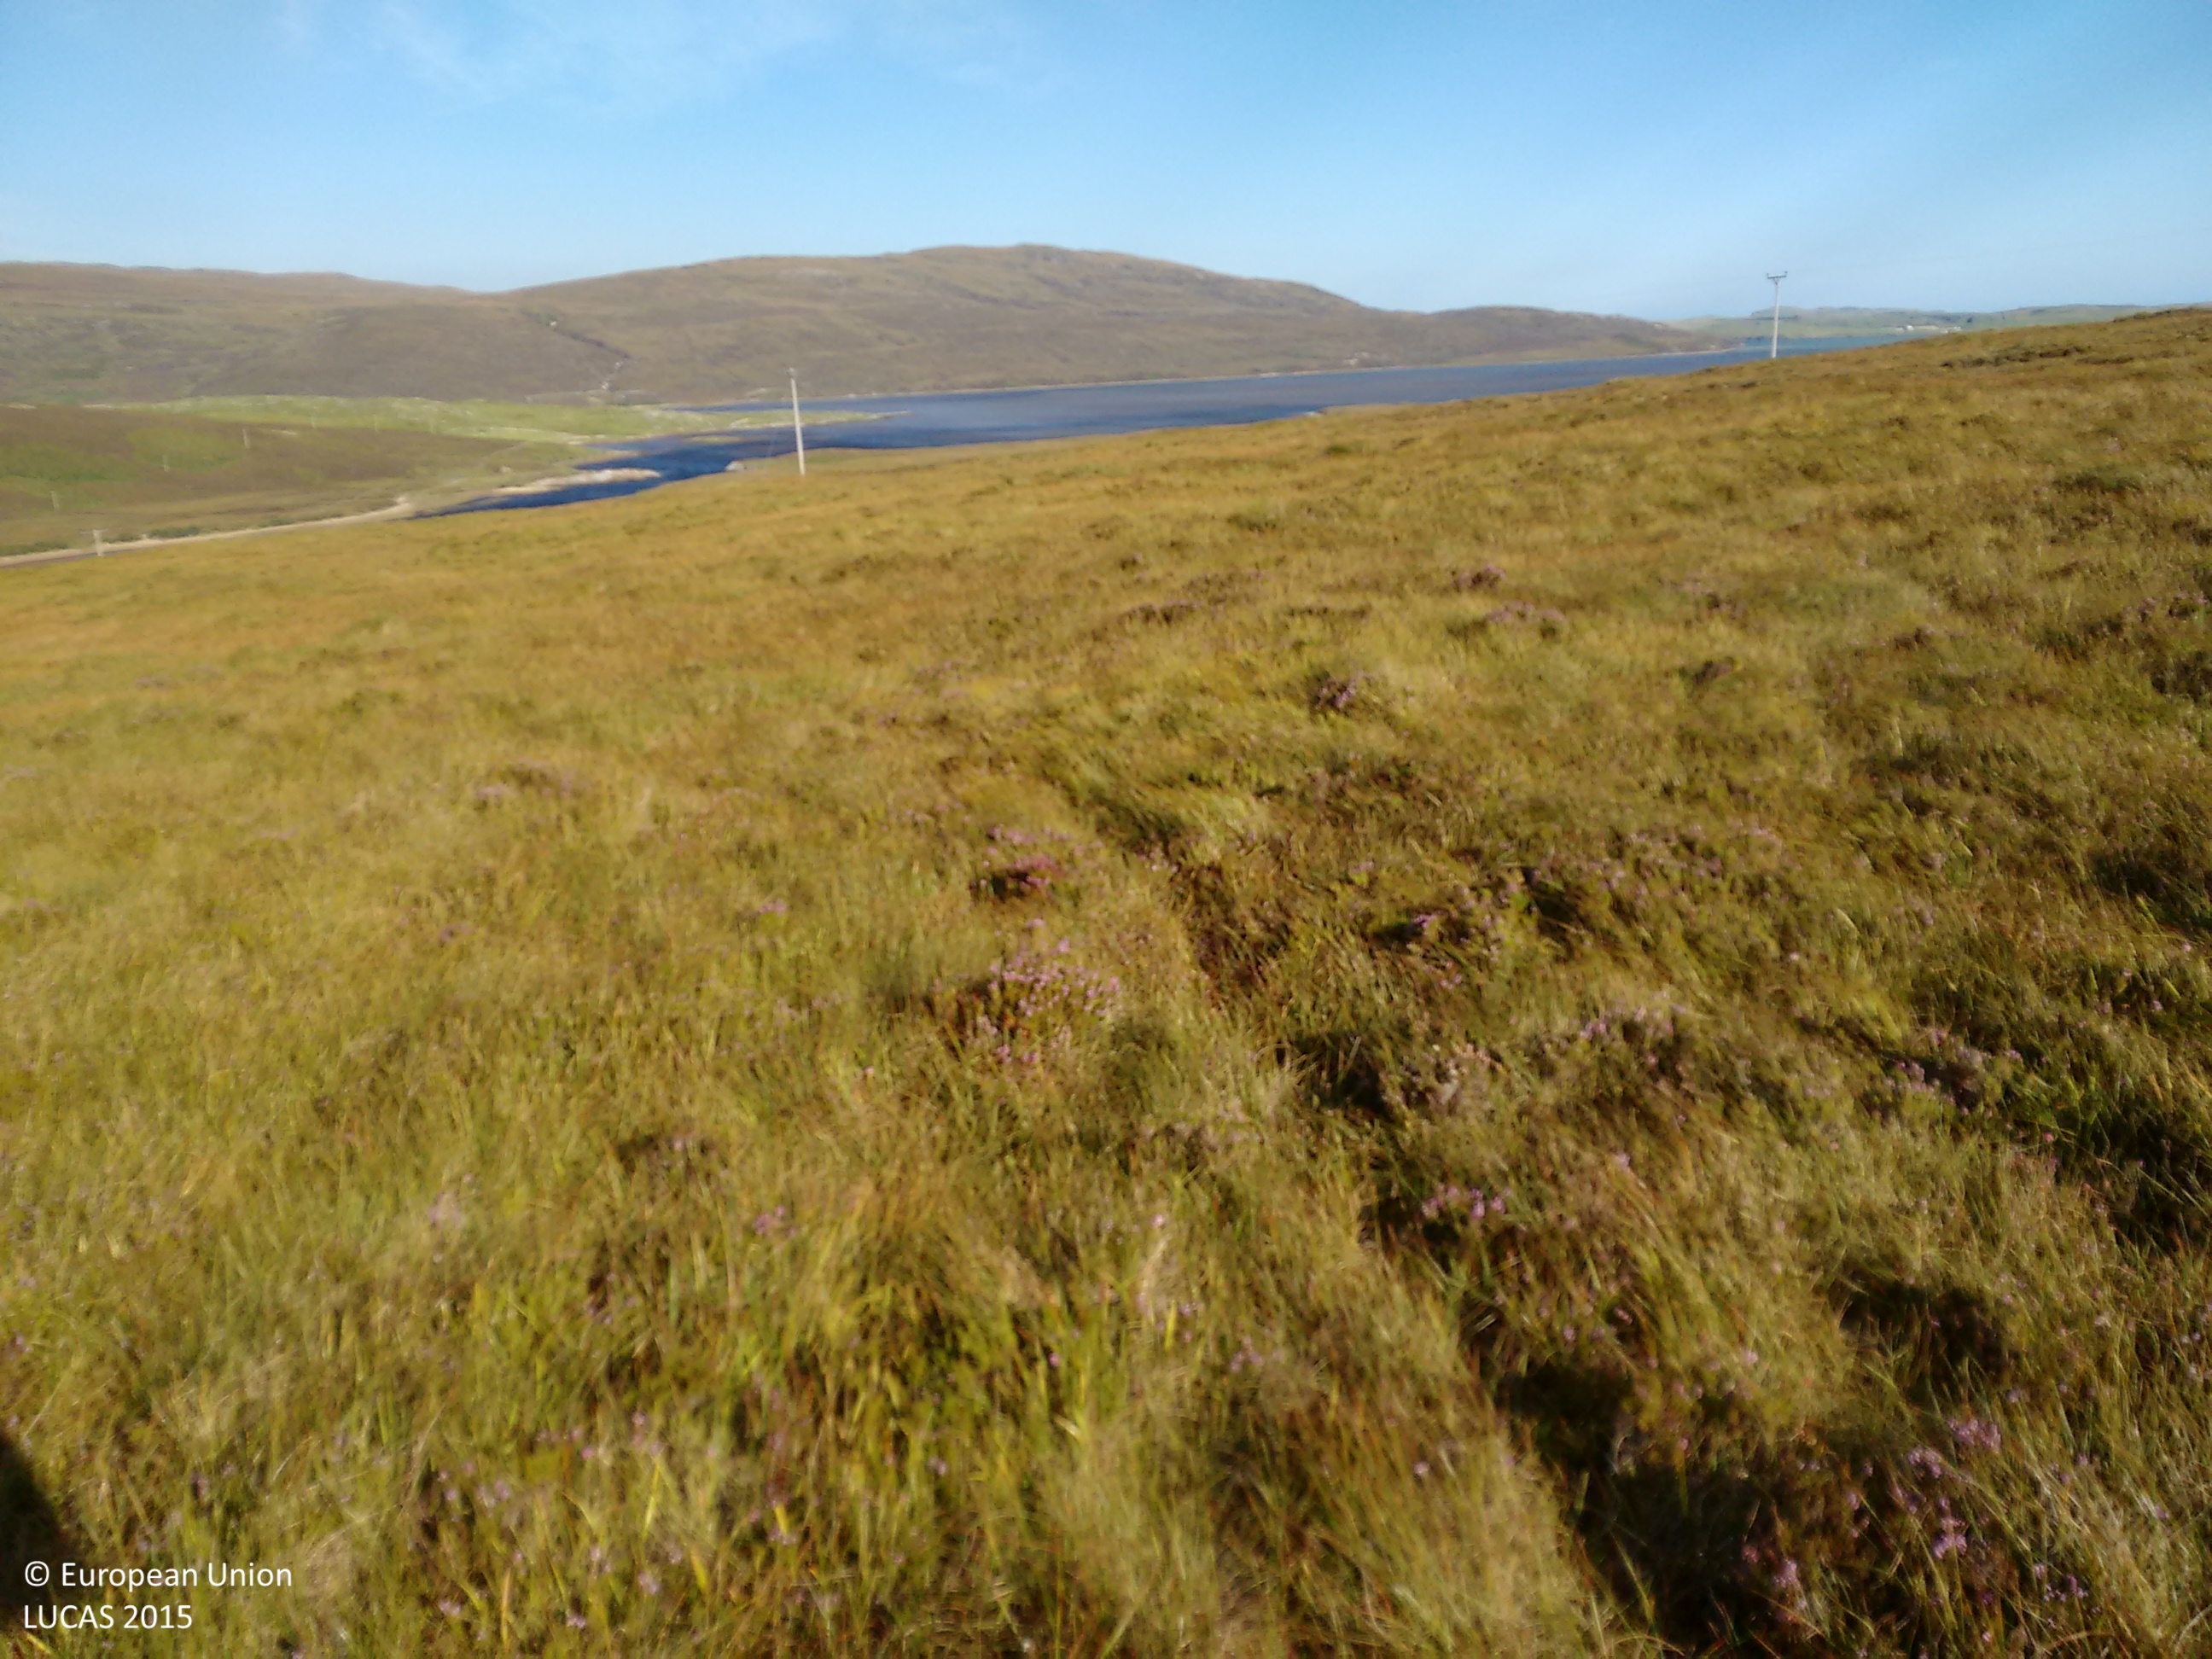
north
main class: Shrubland
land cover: Shrubland without tree cover
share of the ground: 25 - 50 %
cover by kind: herbaceous plants 70 %, shrubs 30 %
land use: Agriculture (excluding fallow land and kitchen gardens)
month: September
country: GB
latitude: 58.5121
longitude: -4.8023
